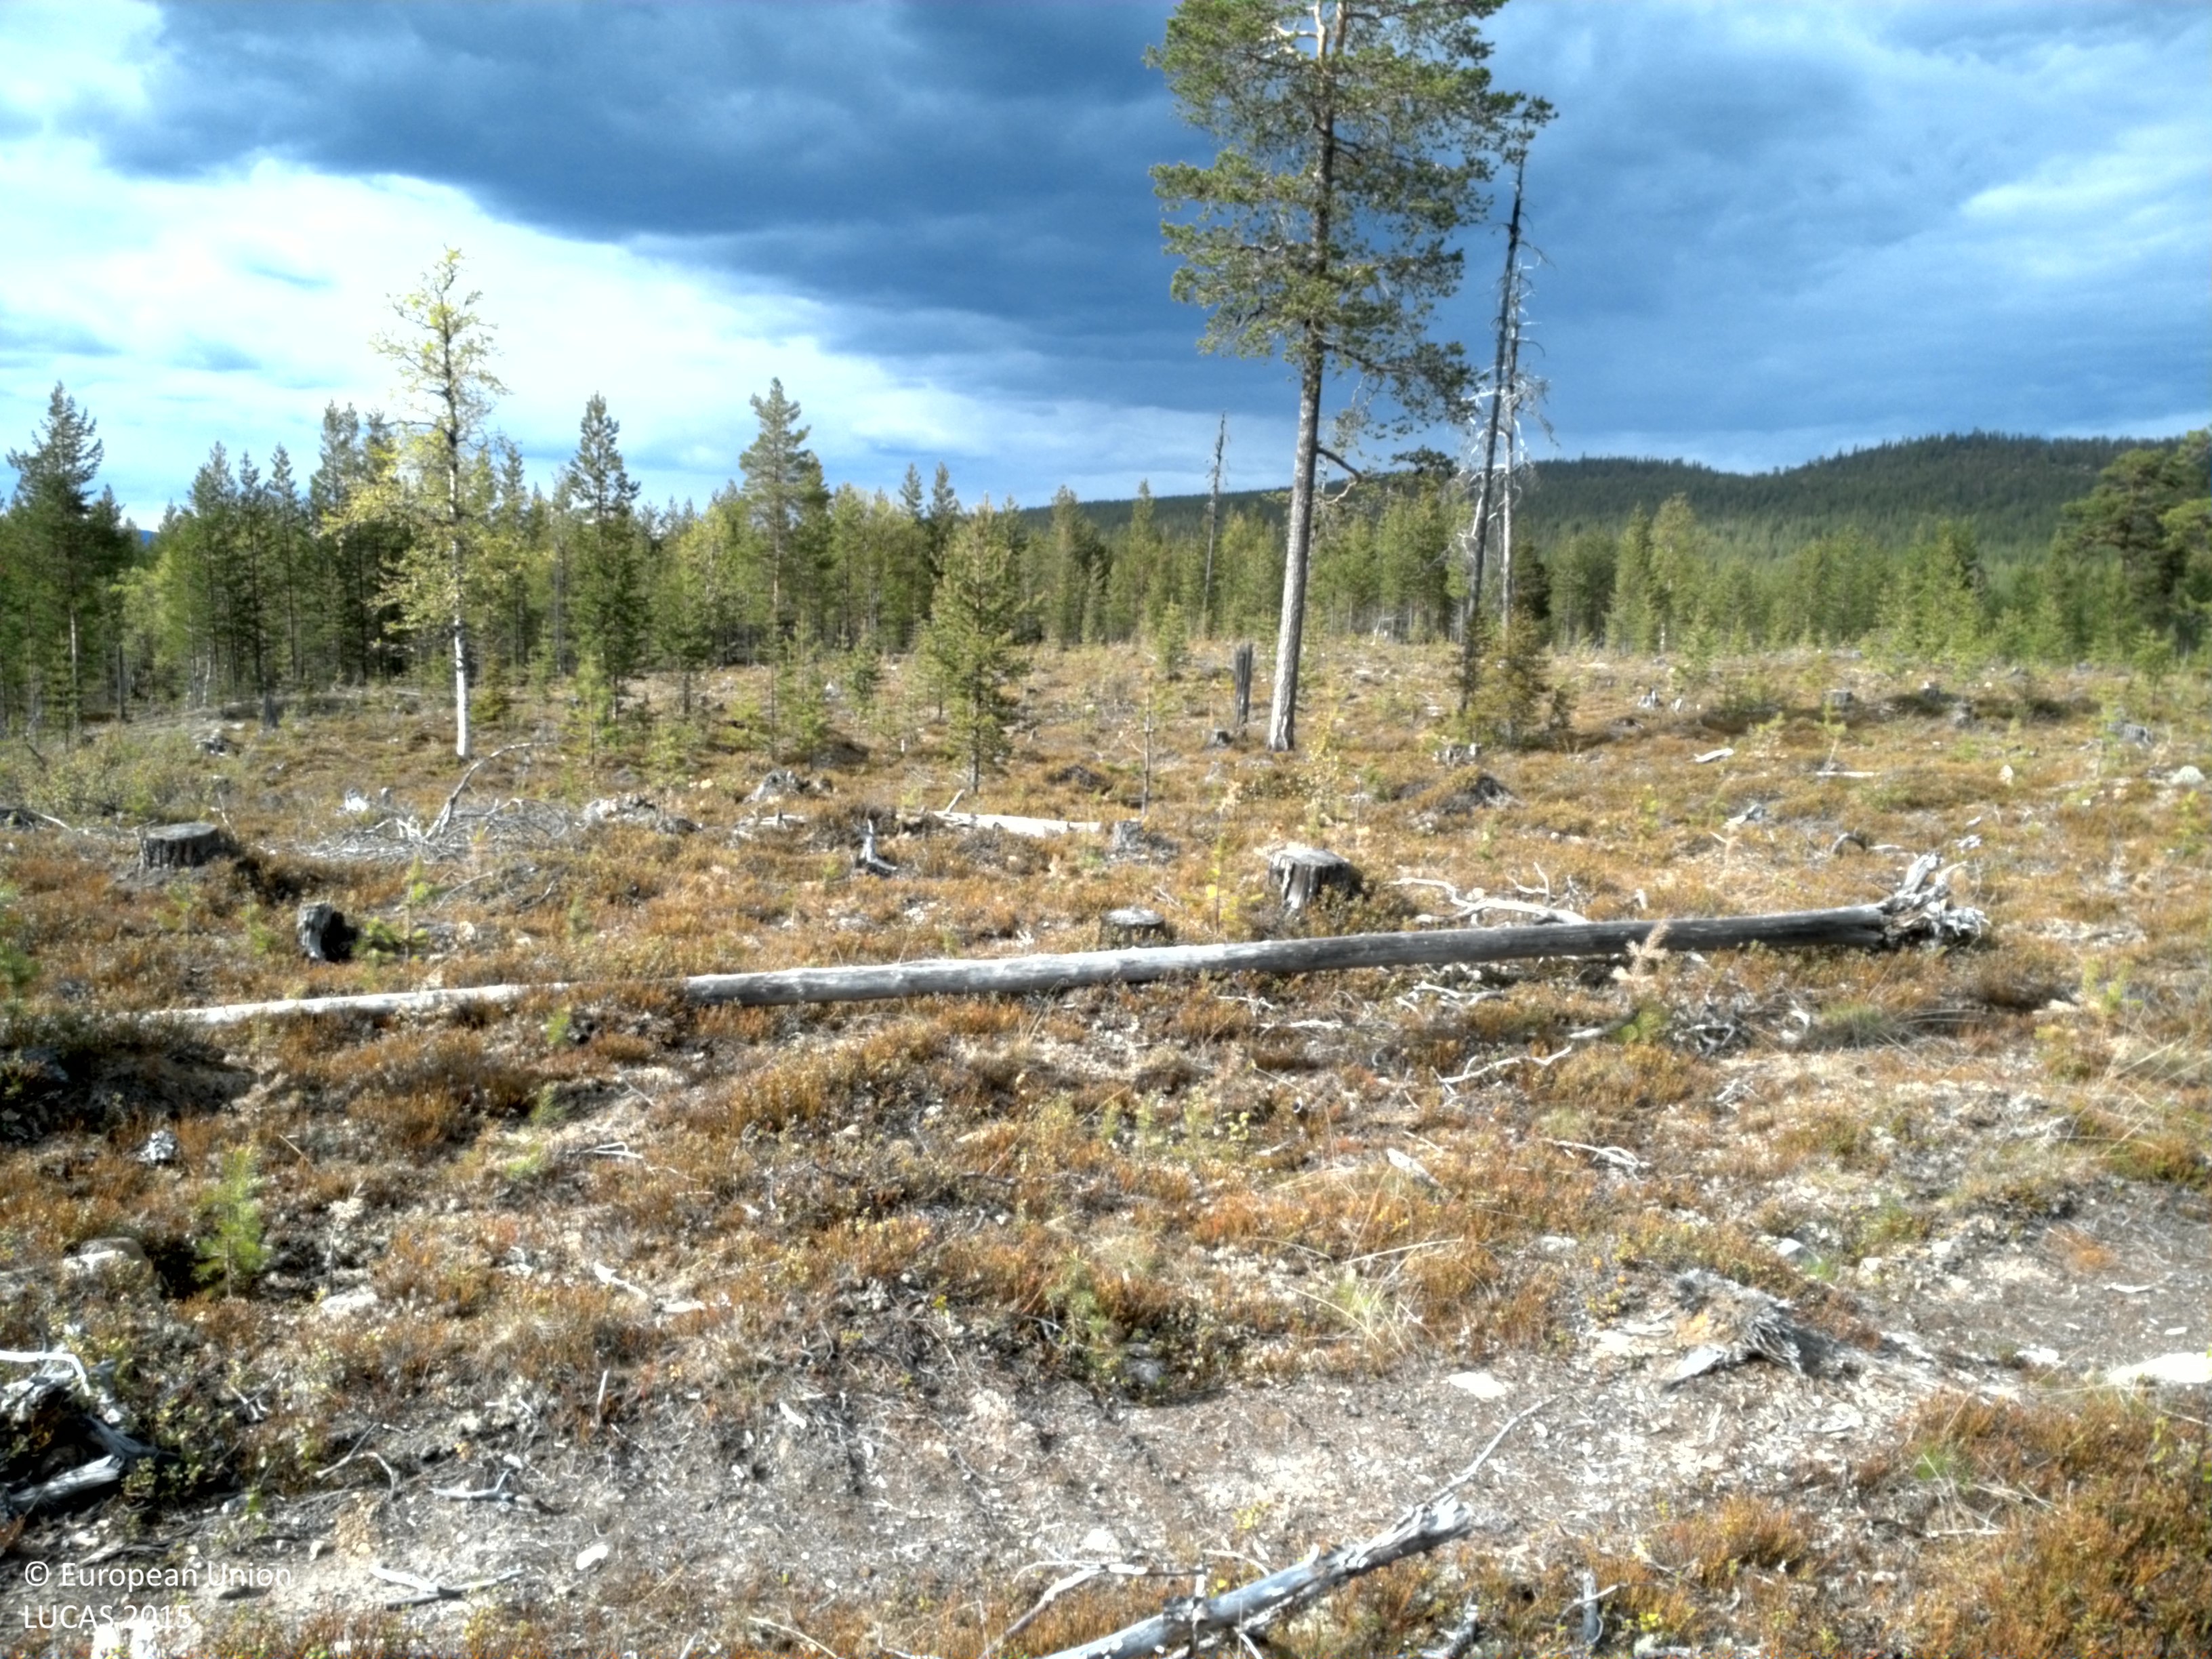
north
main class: Shrubland
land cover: Shrubland with sparse tree cover
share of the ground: > 75 %
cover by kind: shrubs 90 %, coniferous forest trees 5 %, herbaceous plants 5 %
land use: Forestry
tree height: < 5 m
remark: Clear cut
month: June
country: SE
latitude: 66.2122
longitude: 18.7745
